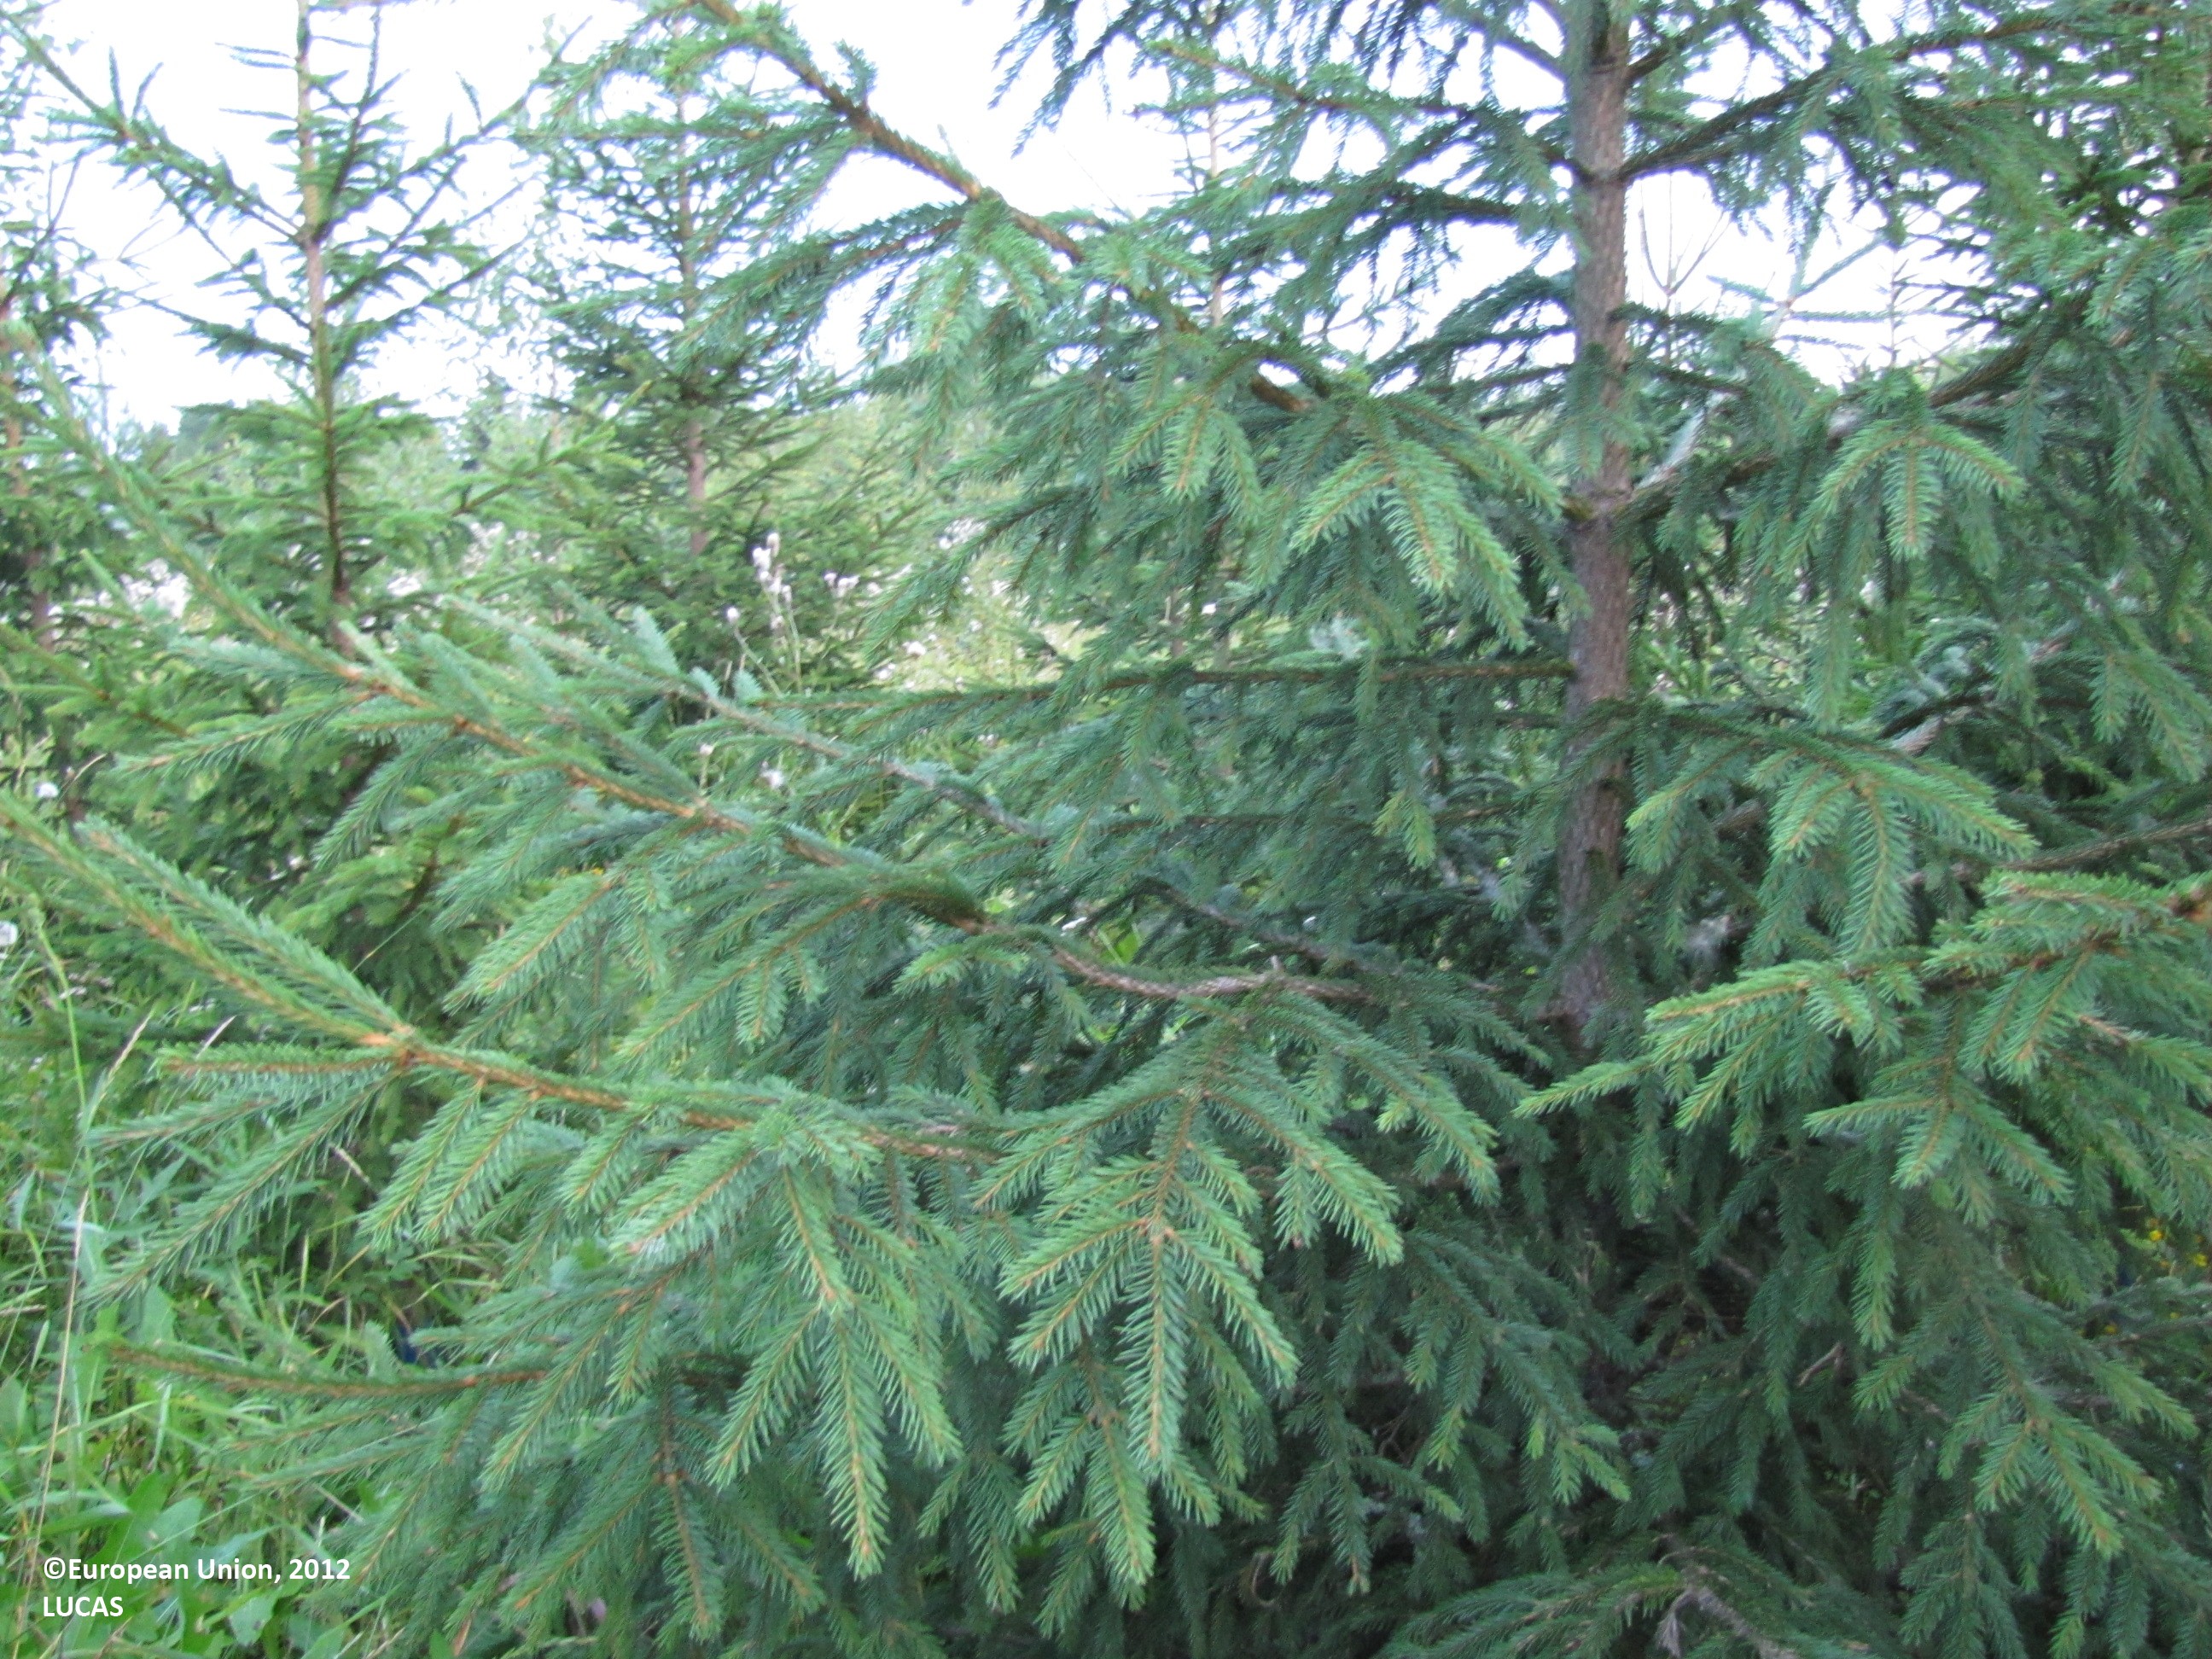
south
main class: Woodland
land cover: Spruce dominated coniferous woodland
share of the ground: 50 - 75 %
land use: Forestry
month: August
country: FI
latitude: 61.4412
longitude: 23.6014
